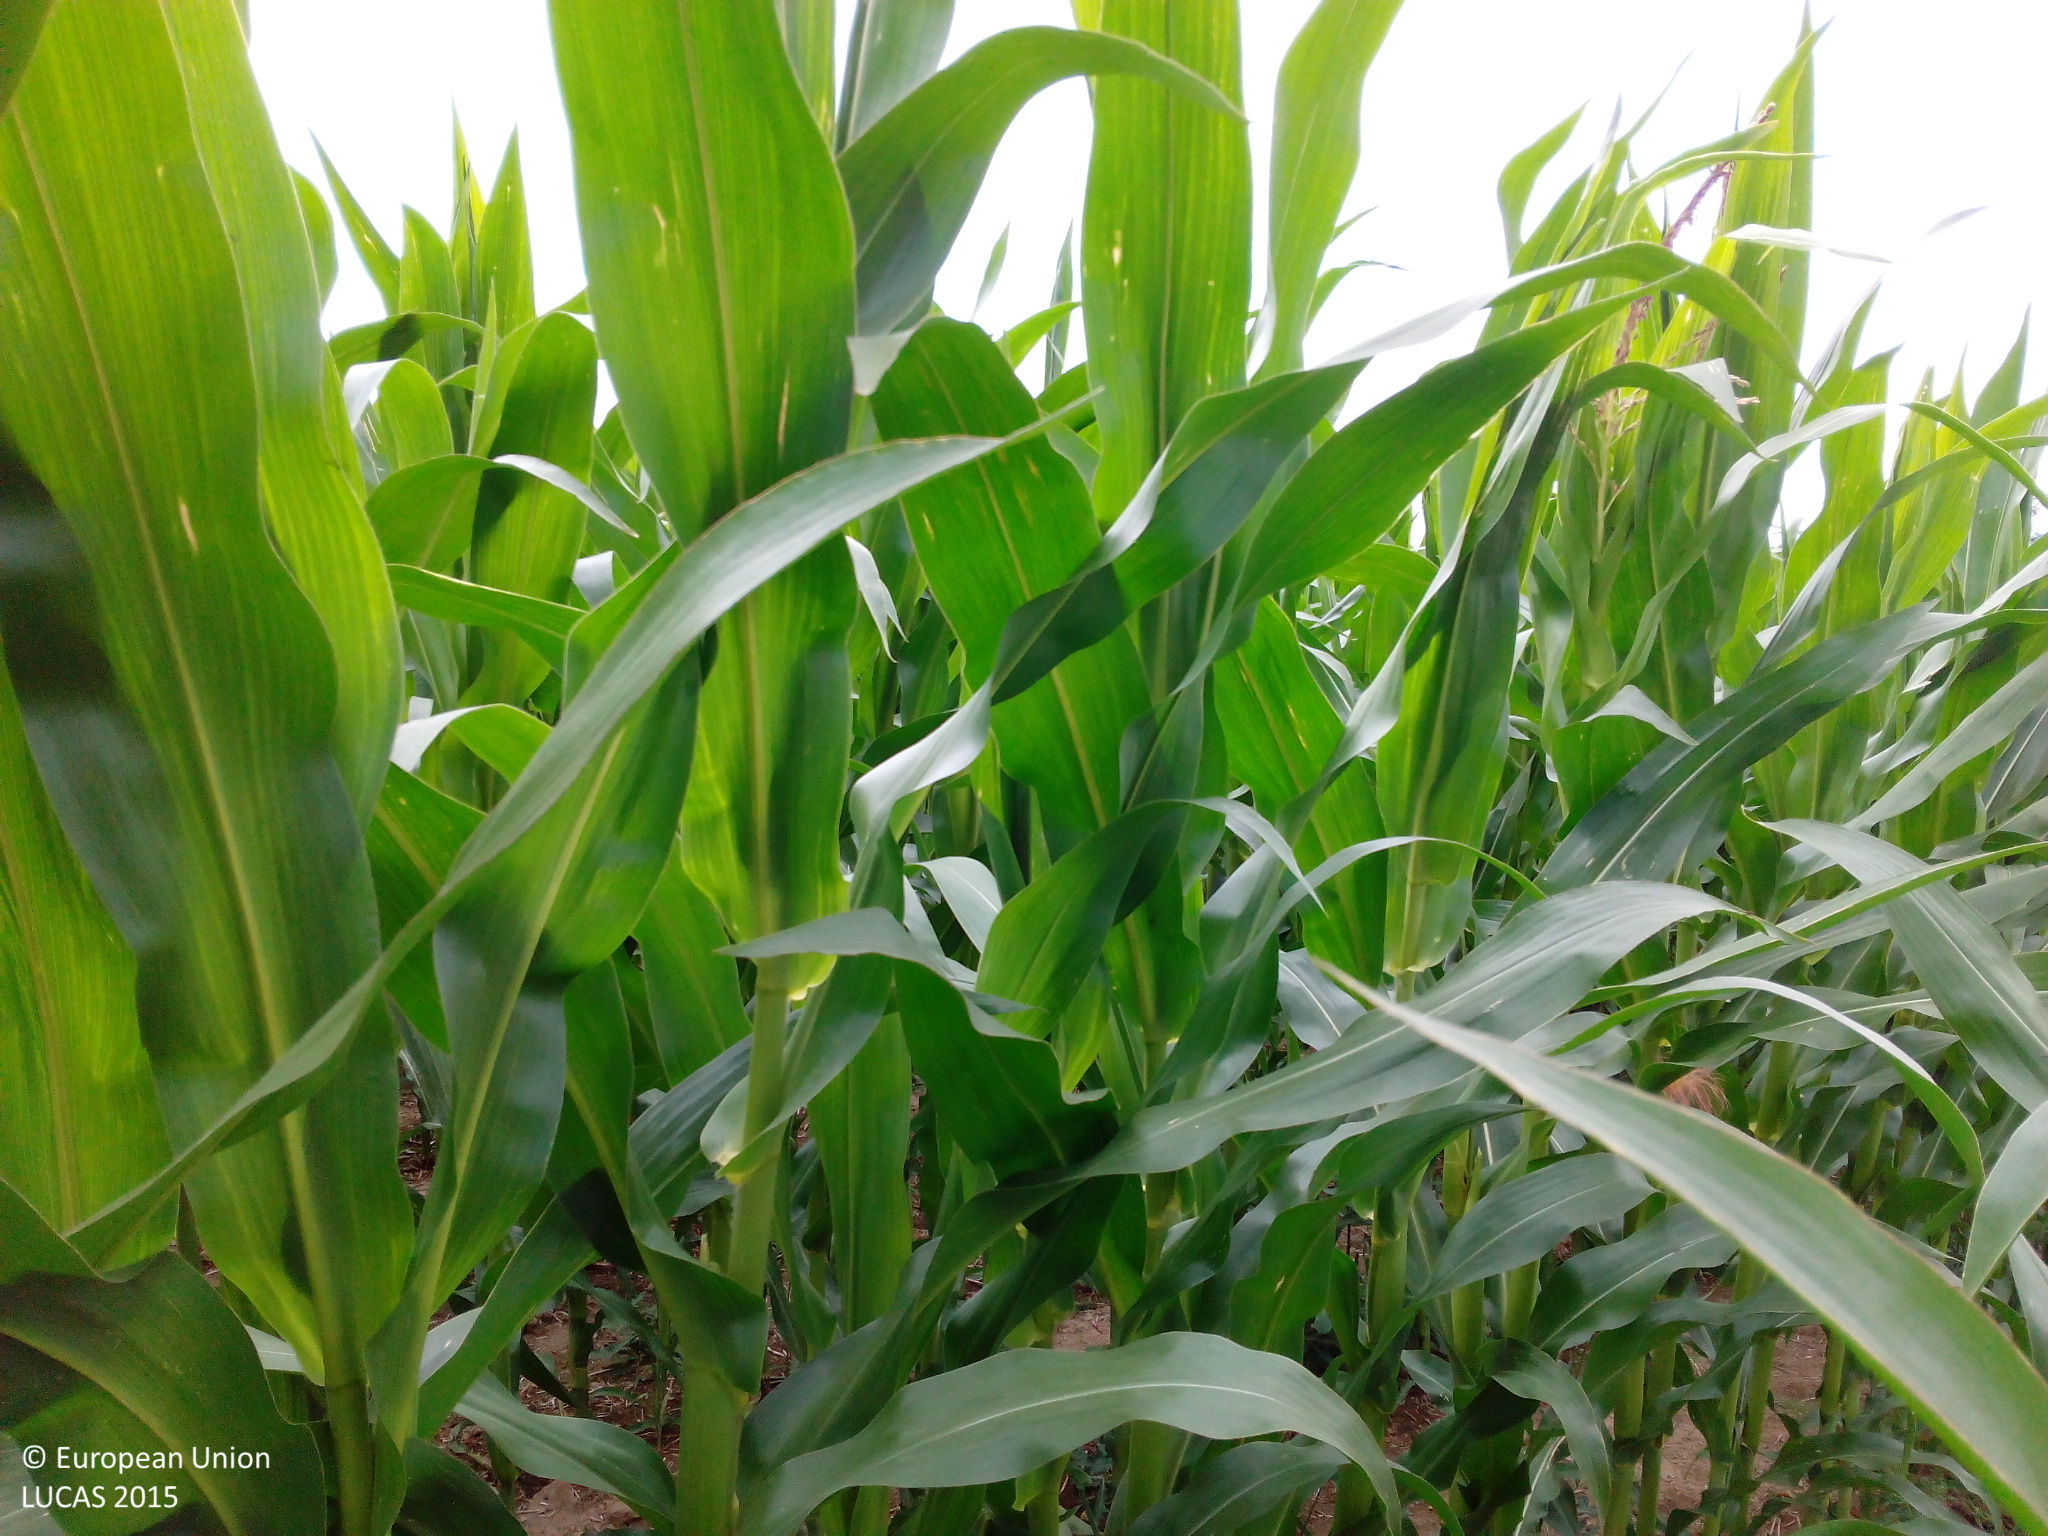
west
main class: Cropland
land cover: Maize
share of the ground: > 75 %
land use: Agriculture (excluding fallow land and kitchen gardens)
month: July
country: DE
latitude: 49.8159
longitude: 12.4596
